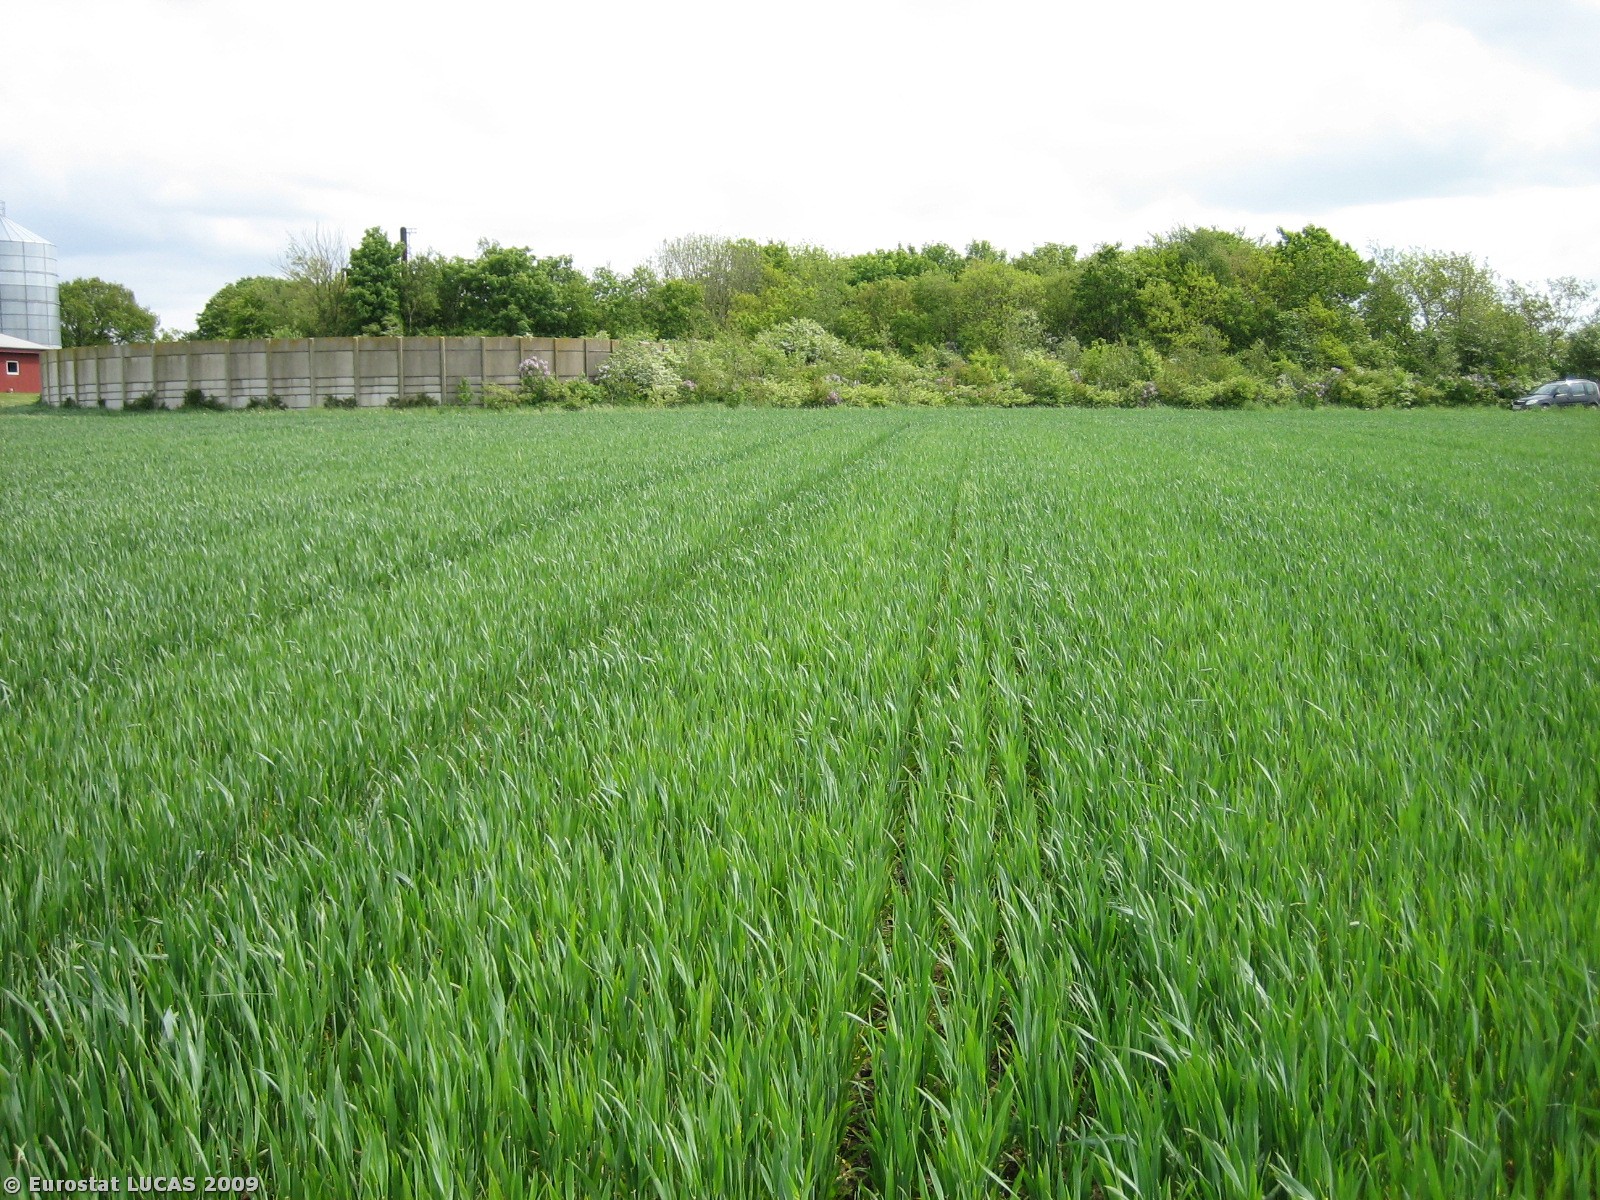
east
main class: Cropland
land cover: Common wheat
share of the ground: > 75 %
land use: Agriculture (excluding fallow land and kitchen gardens)
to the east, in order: Common wheat; Grass margins; Tracks; Grass margins; Shrubland without tree cover; Broadleaved woodland; Paved roads, cycling and walking lanes; Grass margins; Barley; Grass margins; Paved roads, cycling and walking lanes; Broadleaved woodland; Grassland without tree/shrub cover
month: May
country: DK
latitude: 56.2180
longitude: 8.7920
